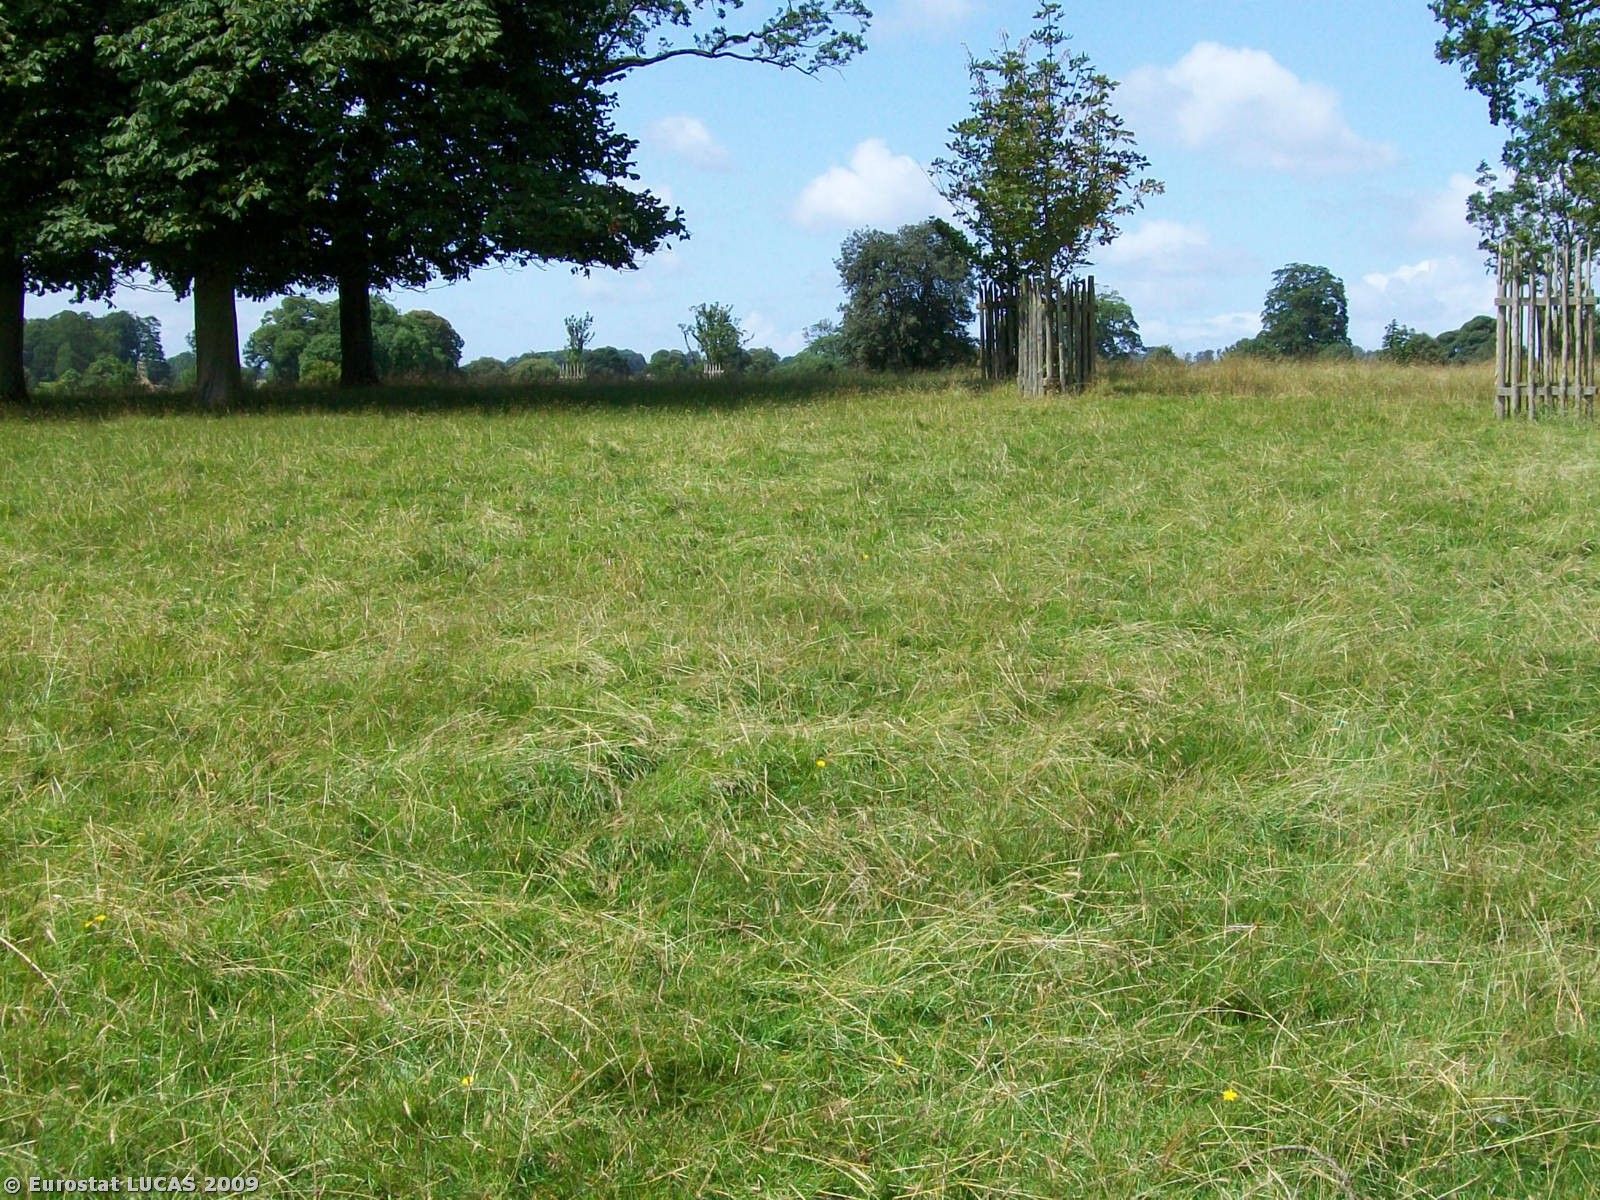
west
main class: Grassland
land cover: Grassland without tree/shrub cover
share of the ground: > 75 %
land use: Amenities, museums, leisure
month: July
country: GB
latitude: 51.5551
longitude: -2.2791
